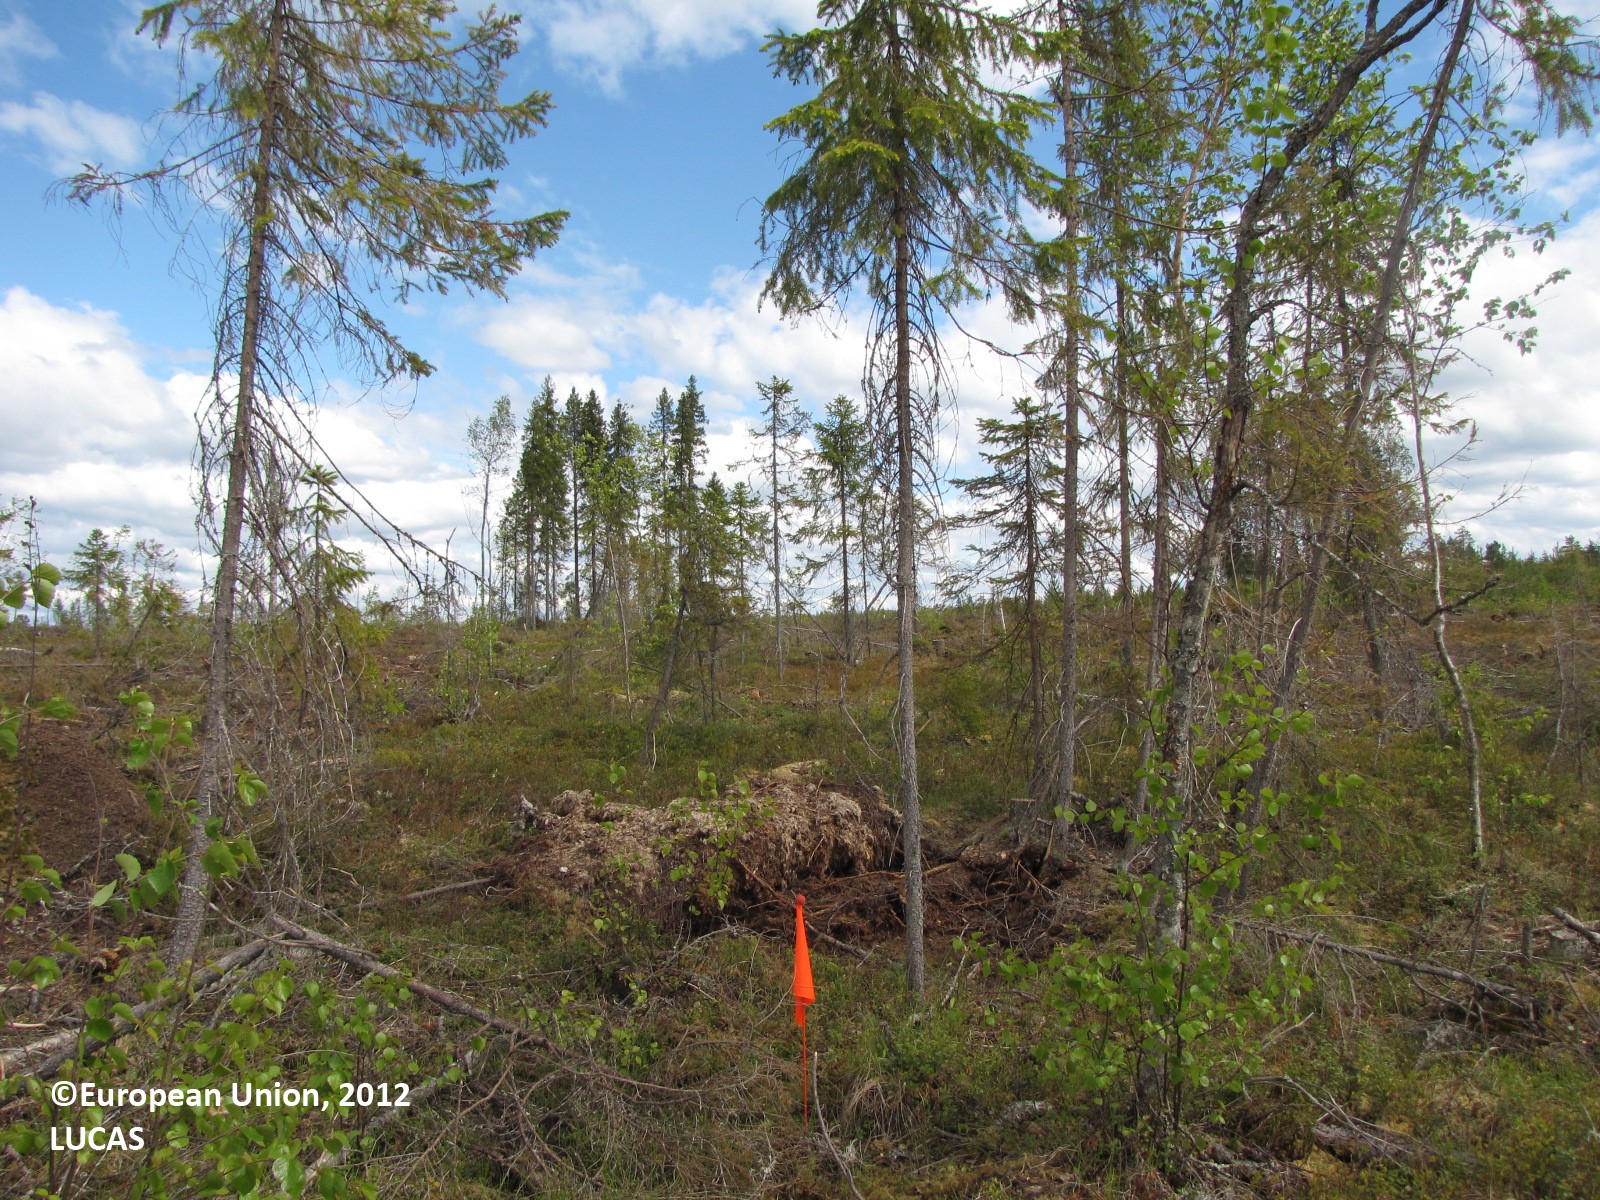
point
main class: Woodland
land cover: Other mixed woodland
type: boreal forest
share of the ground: 10 - 25 %
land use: Forestry
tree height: > 5 m
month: June
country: FI
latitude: 66.1069
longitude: 25.1294
